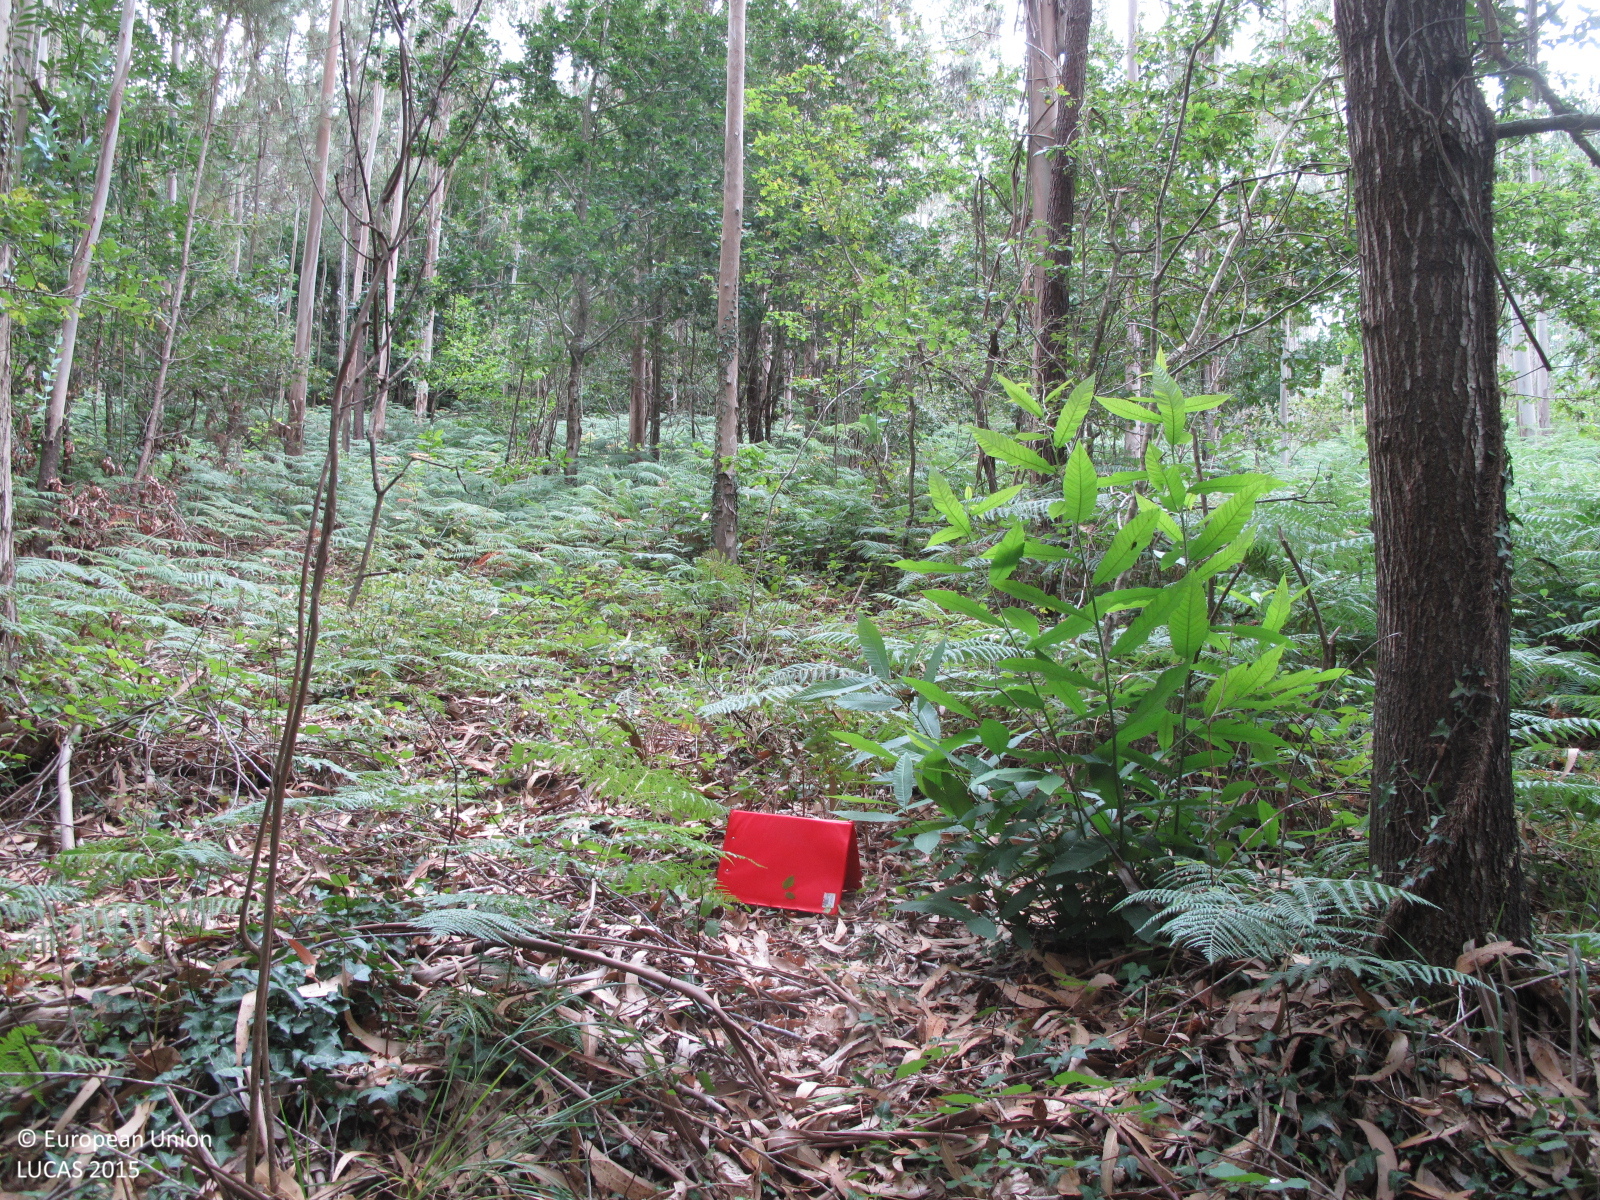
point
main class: Woodland
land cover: Broadleaved woodland
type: exotic forest
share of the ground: 50 - 75 %
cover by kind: broadleaved forest trees 60 %, shrubs 20 %, herbaceous plants 20 %
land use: Forestry
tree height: > 5 m
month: July
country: ES
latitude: 42.8632
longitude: -8.4488
